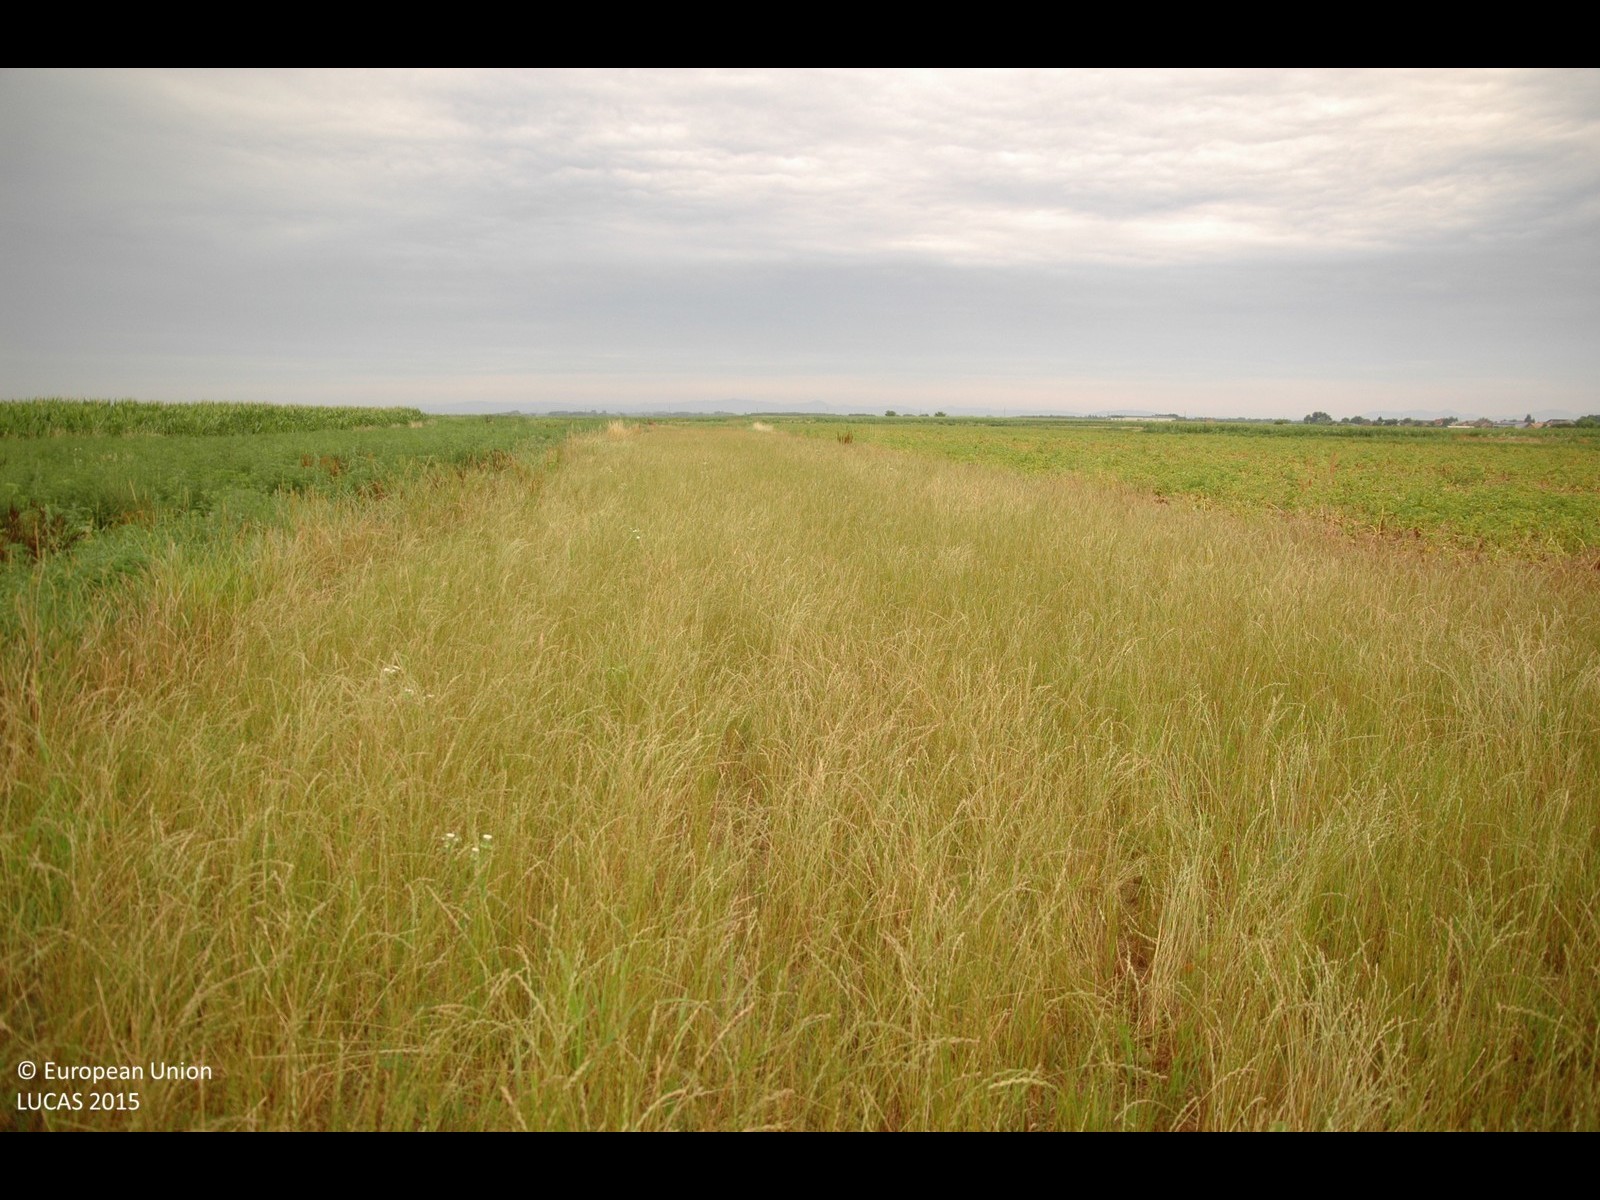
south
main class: Grassland
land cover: Grassland without tree/shrub cover
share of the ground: > 75 %
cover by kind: herbaceous plants 100 %
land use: Agriculture (excluding fallow land and kitchen gardens)
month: July
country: HR
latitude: 46.3741
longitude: 16.4357
